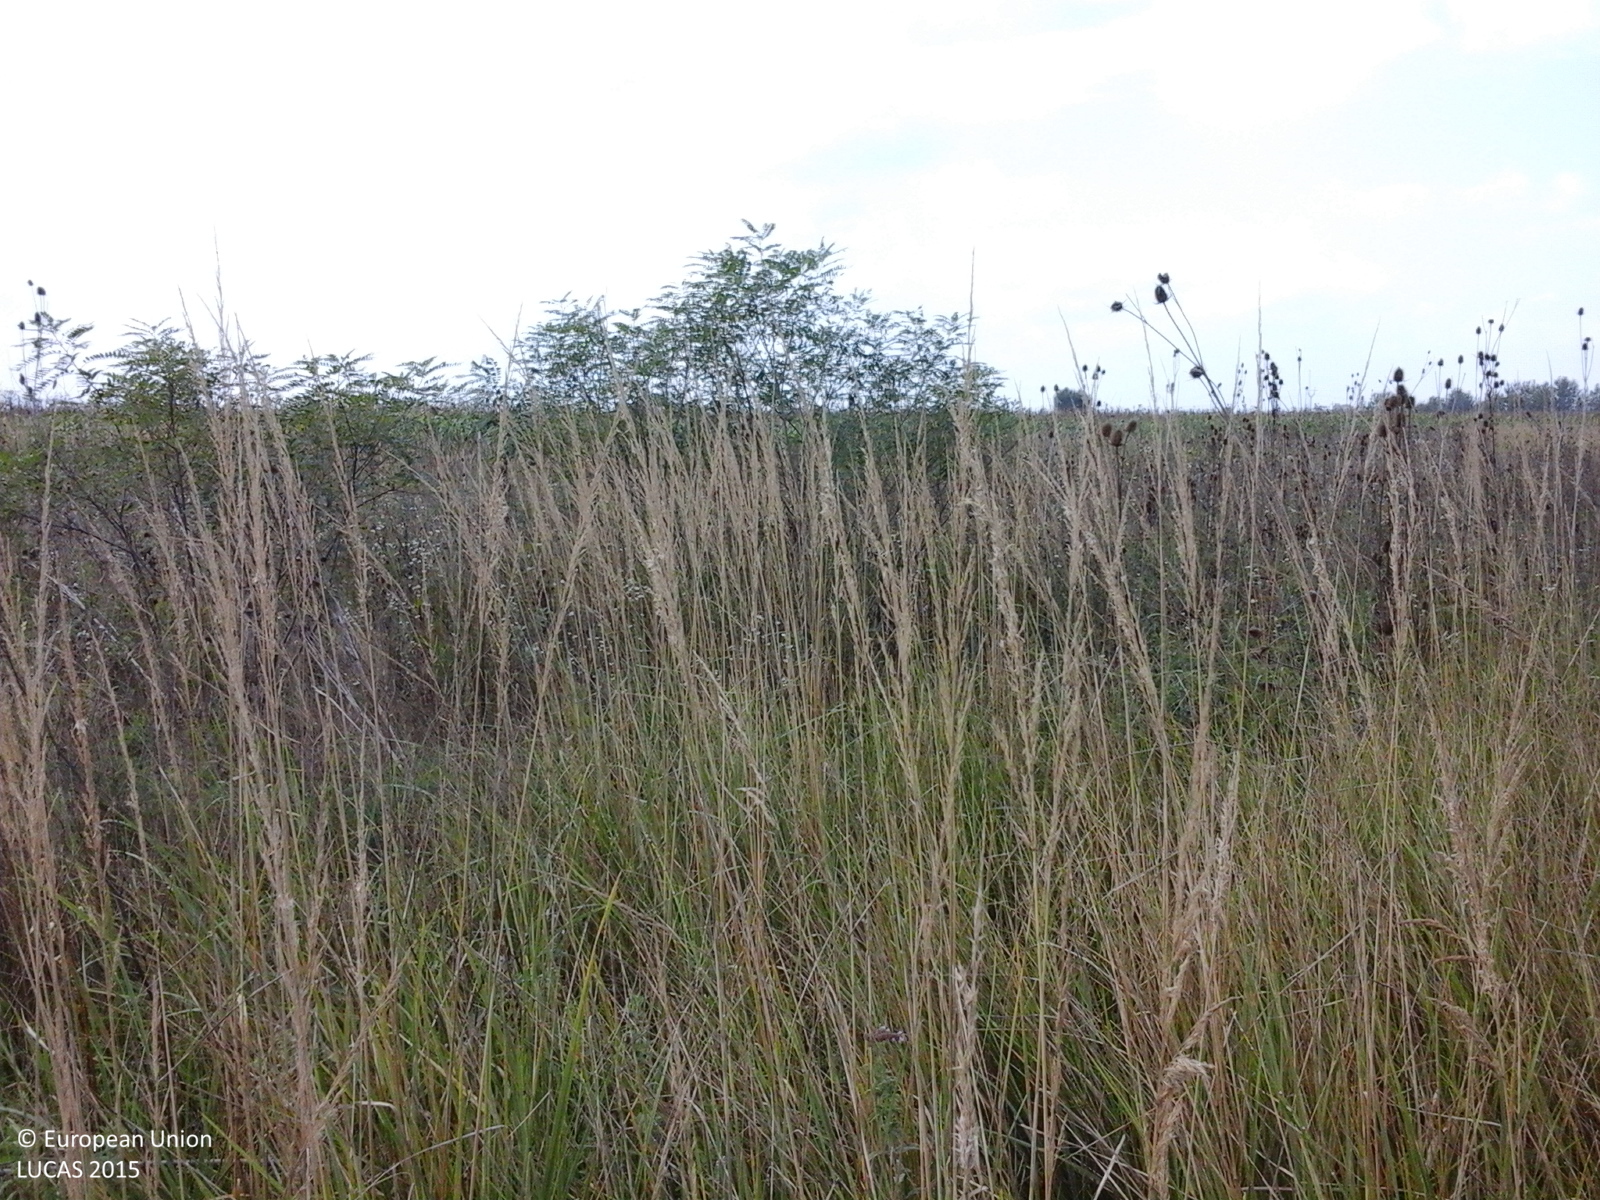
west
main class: Grassland
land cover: Spontaneously vegetated surfaces
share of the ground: > 75 %
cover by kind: herbaceous plants 100 %
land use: Forestry
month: September
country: RO
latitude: 45.0151
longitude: 23.3662
